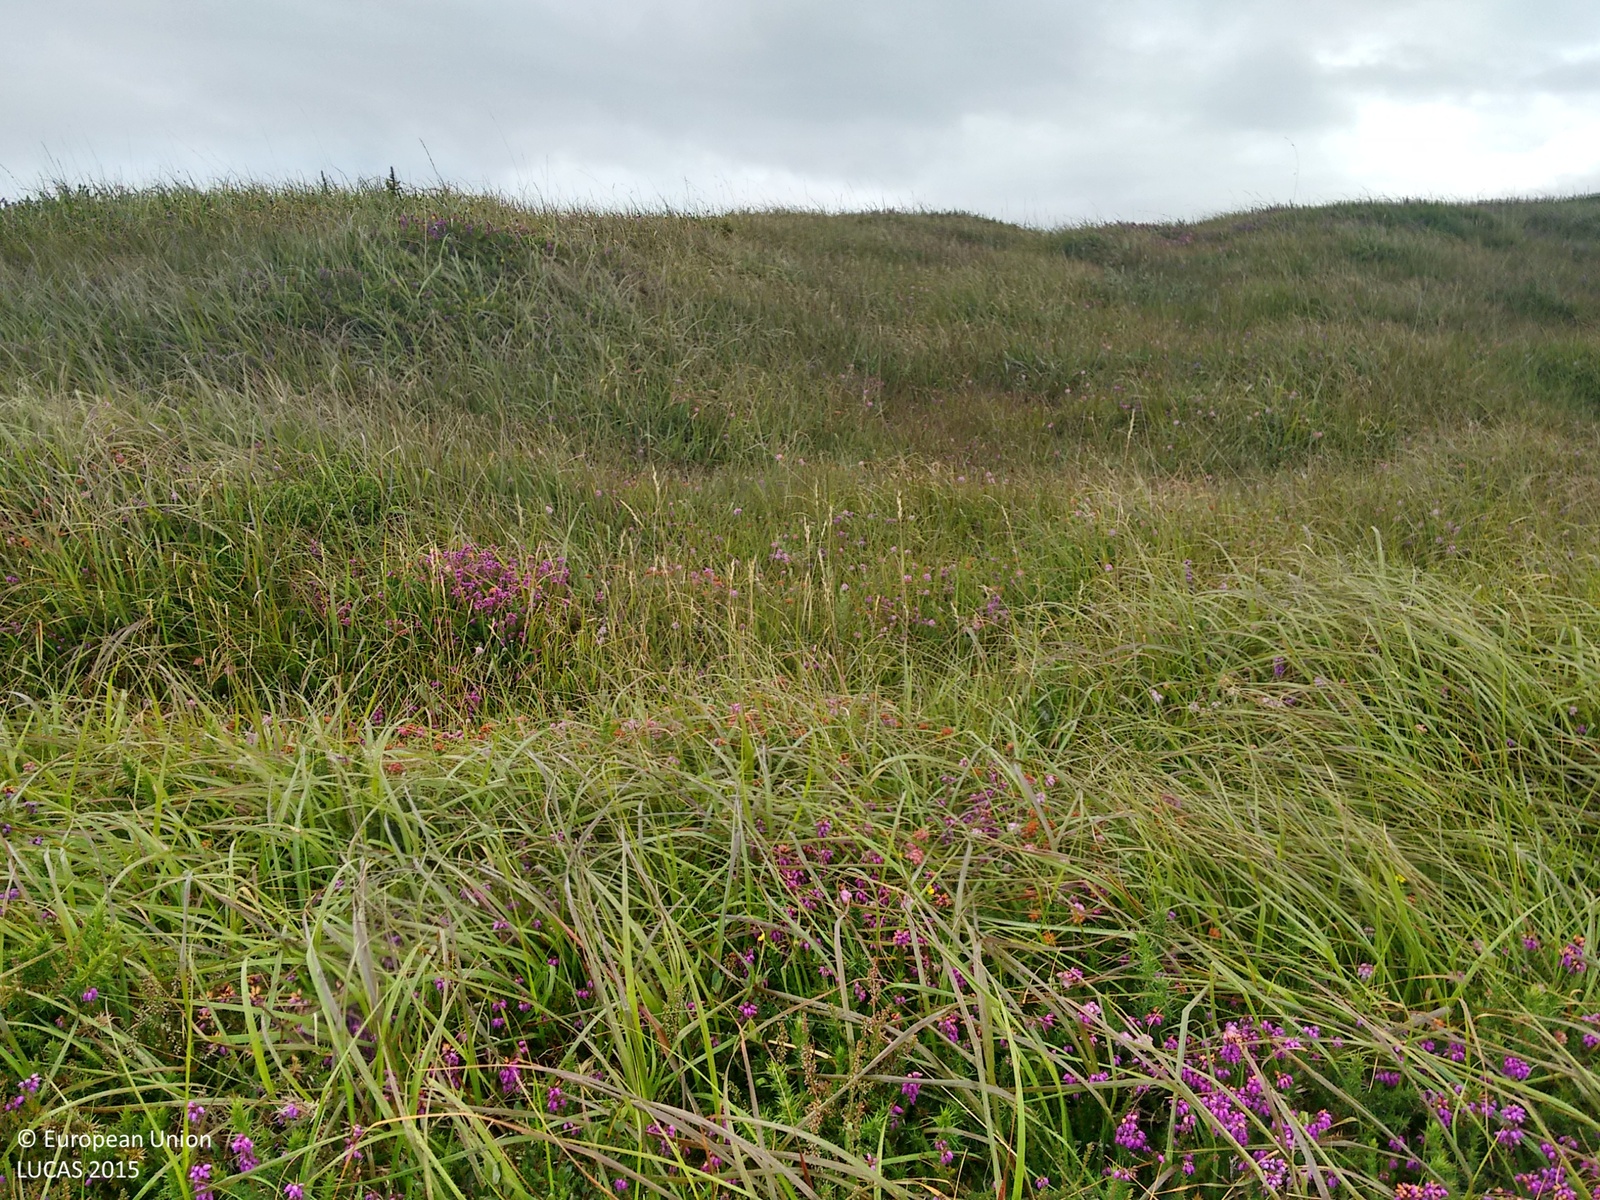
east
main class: Shrubland
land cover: Shrubland without tree cover
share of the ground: > 75 %
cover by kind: shrubs 80 %, herbaceous plants 20 %
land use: Semi-natural and natural areas not in use
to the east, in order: Shrubland without tree cover; Grassland with sparse tree/shrub cover; Artificial constructions; Fences; Single bushes/trees; Shrubland without tree cover; Shrubland with sparse tree cover; Paved roads, cycling and walking lanes; Other bare soil; Shrubland with sparse tree cover; Shrubland without tree cover; Shrubland with sparse tree cover; Ditches and canals; Artificial constructions; Ditches and canals; Shrubland without tree cover
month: July
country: IE
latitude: 51.4961
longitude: -9.2806
